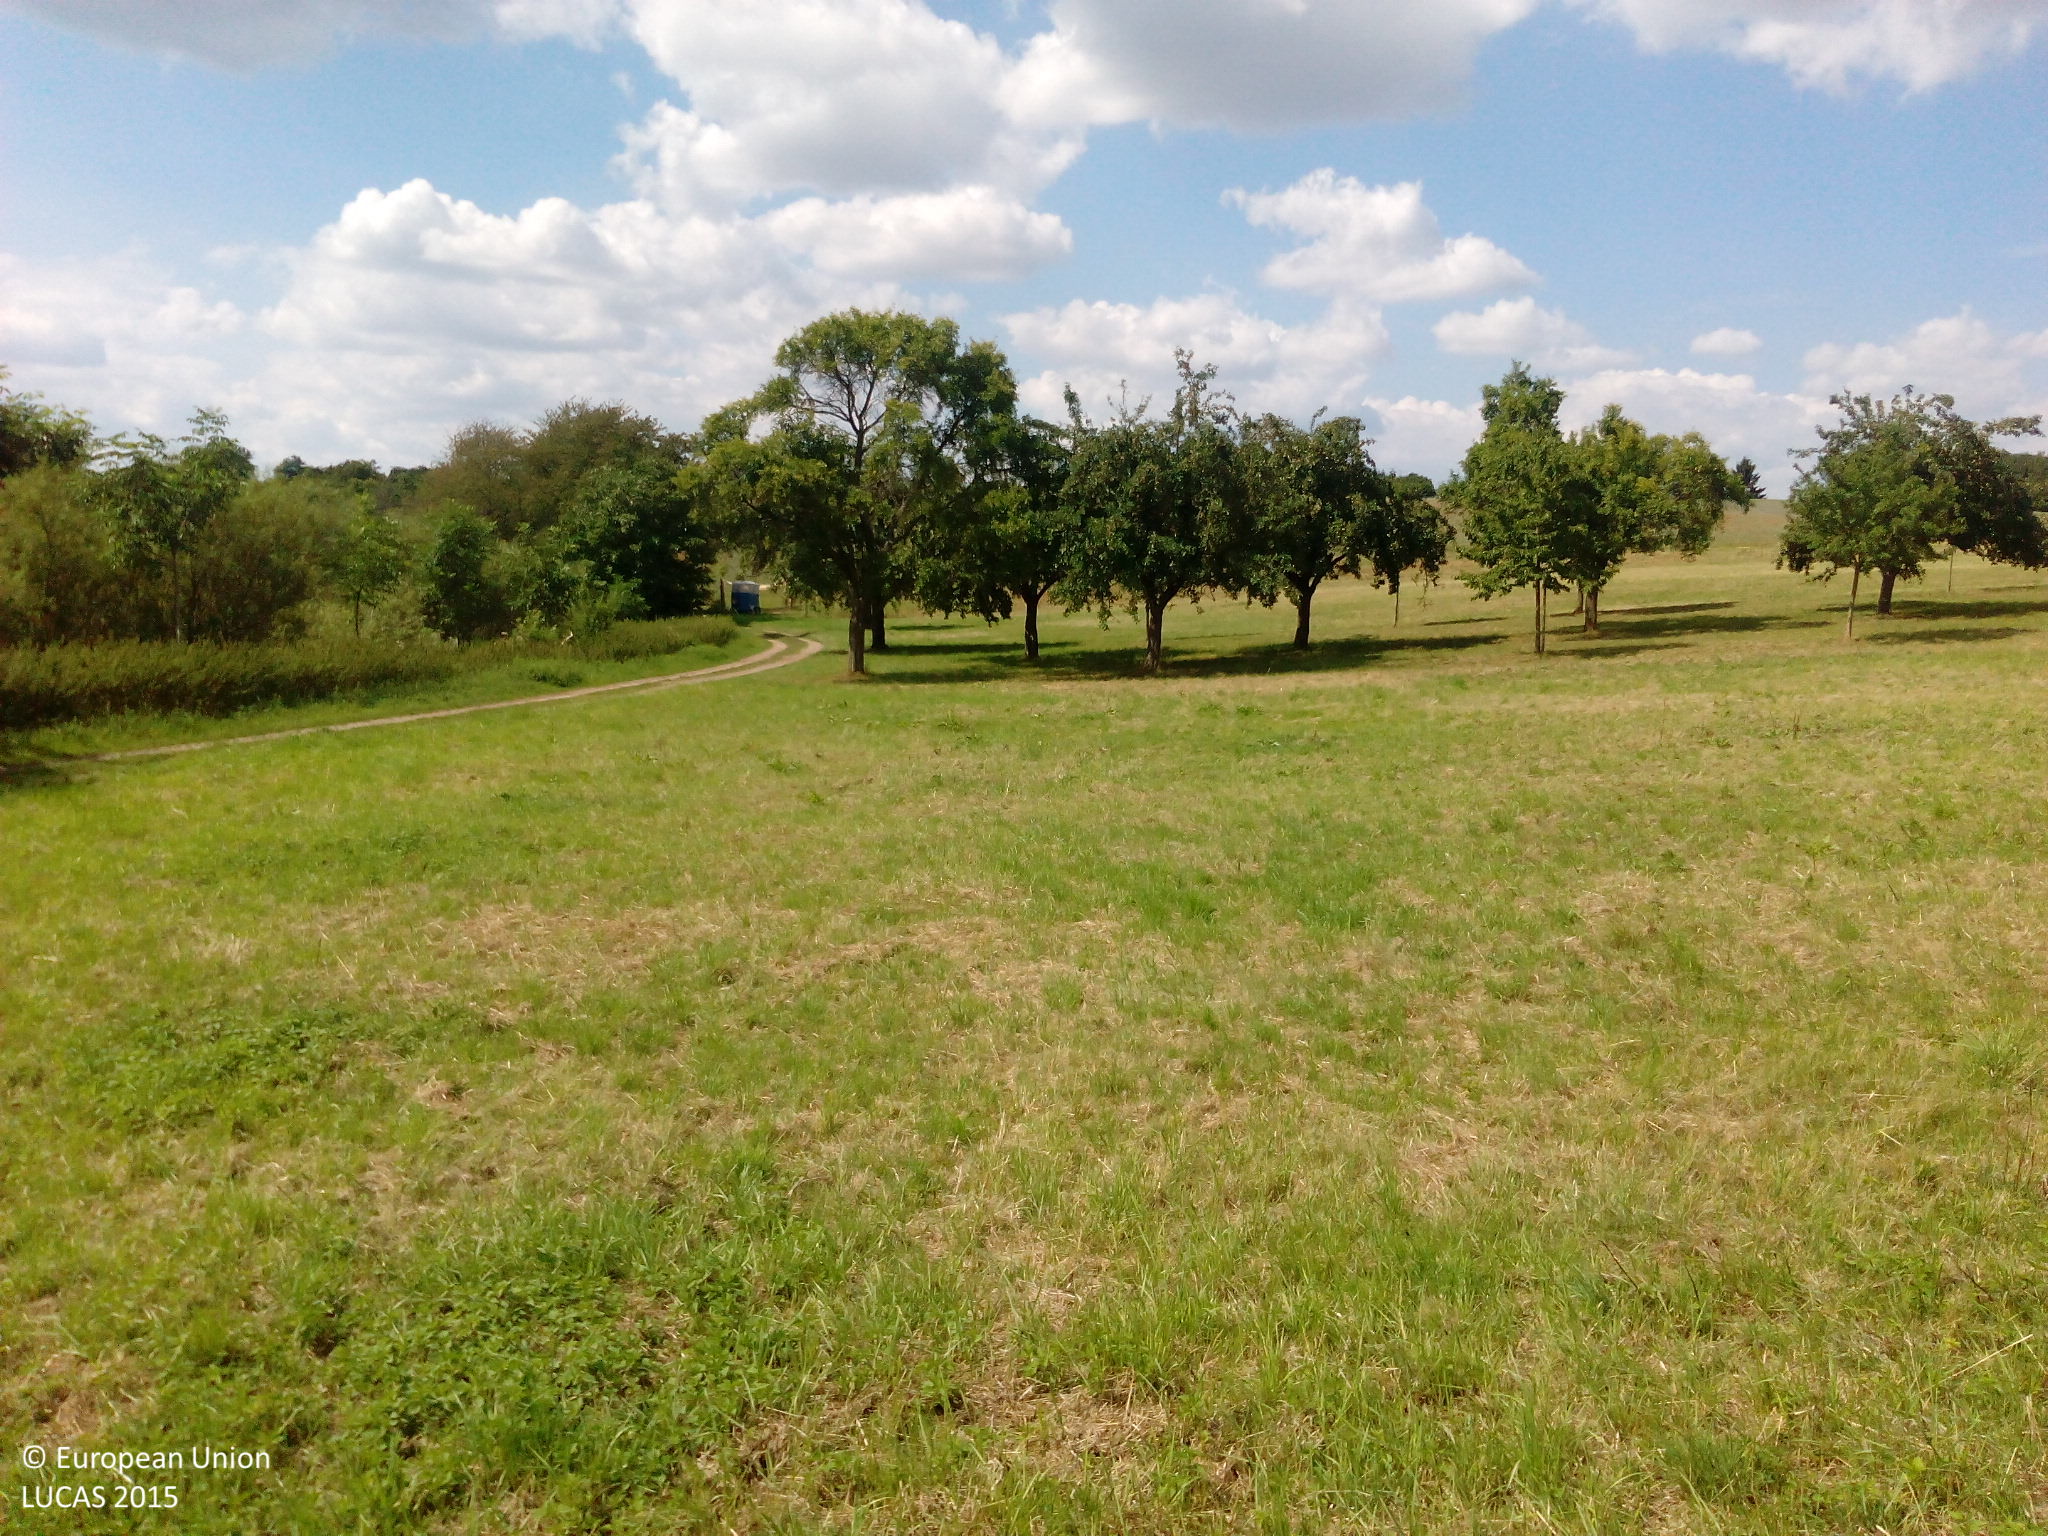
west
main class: Grassland
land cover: Grassland without tree/shrub cover
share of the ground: > 75 %
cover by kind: herbaceous plants 80 %, unconsolidated bare surface 20 %
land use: Agriculture (excluding fallow land and kitchen gardens)
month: August
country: DE
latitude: 50.2107
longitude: 7.4920
